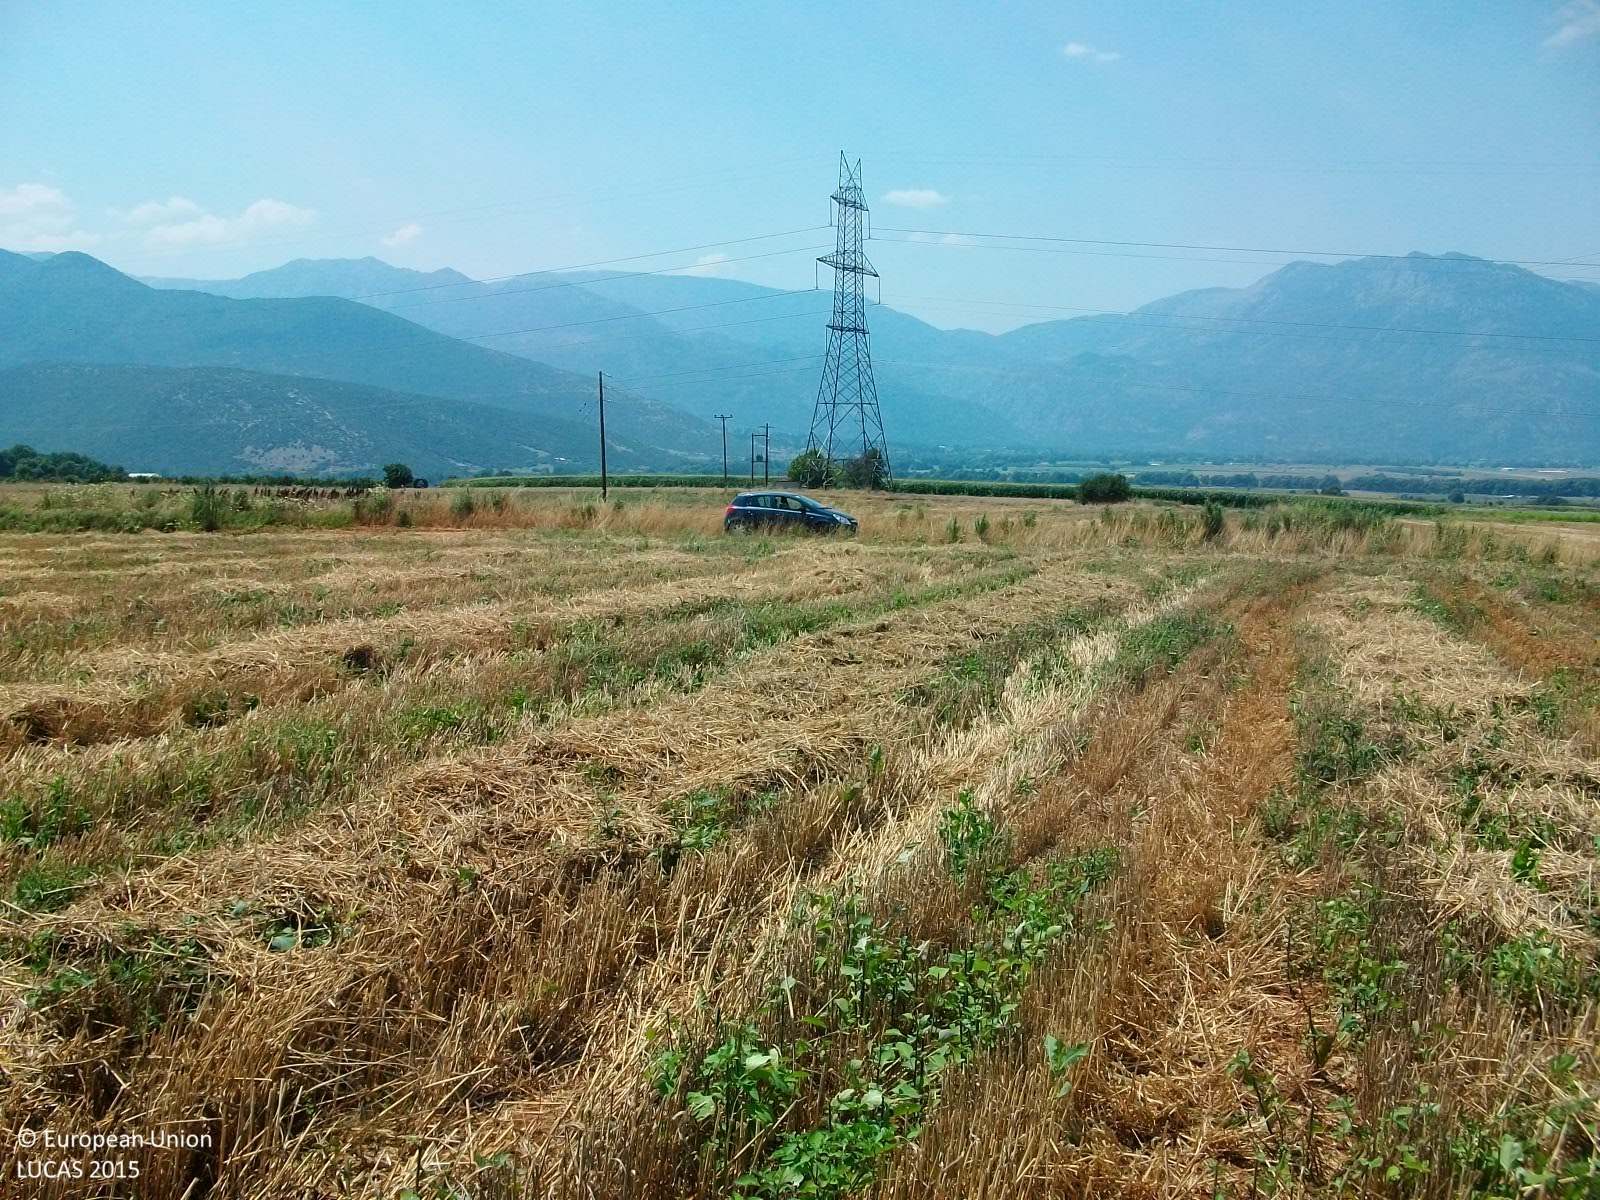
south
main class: Cropland
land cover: Durum wheat
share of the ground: > 75 %
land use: Agriculture (excluding fallow land and kitchen gardens)
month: July
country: GR
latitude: 38.6902
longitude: 22.5449
